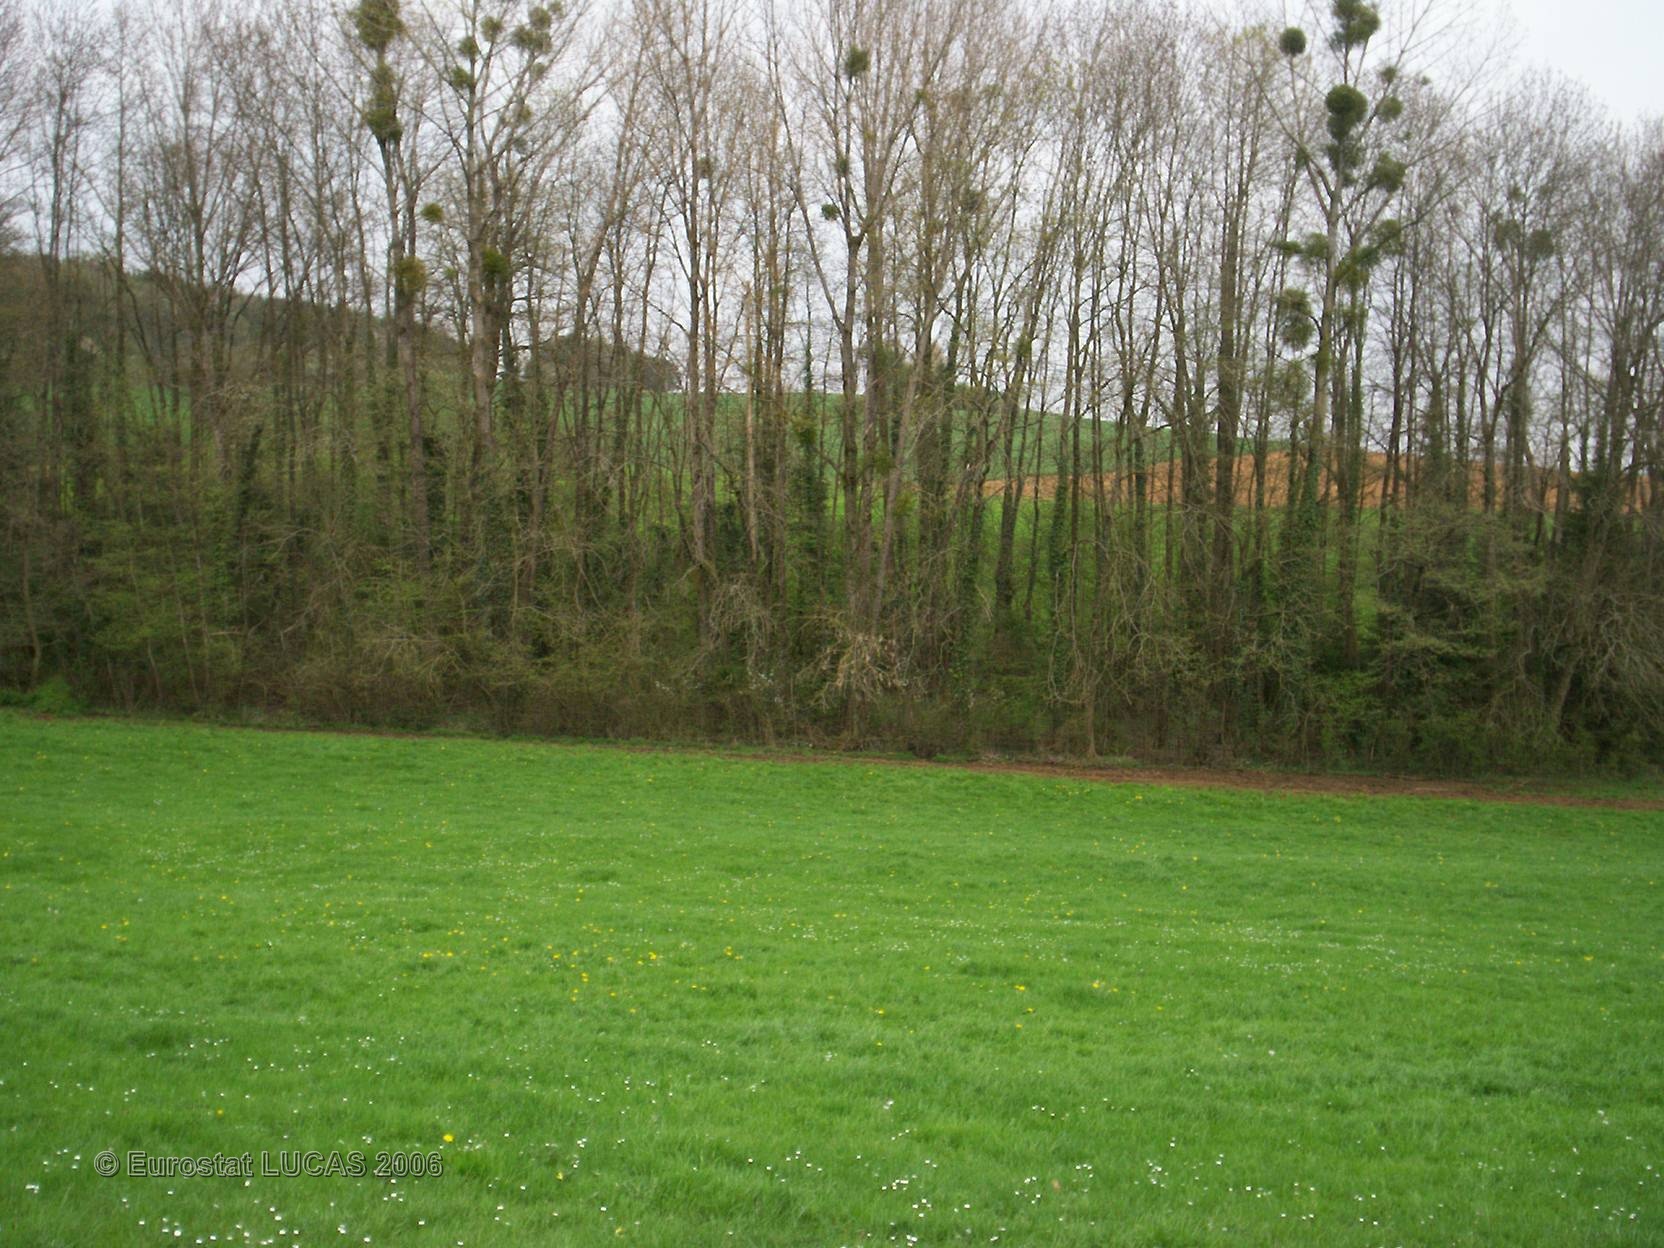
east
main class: Grassland
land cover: Grassland without tree/shrub cover
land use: Agriculture (excluding fallow land and kitchen gardens)
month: April
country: FR
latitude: 49.7651
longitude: 4.5401
